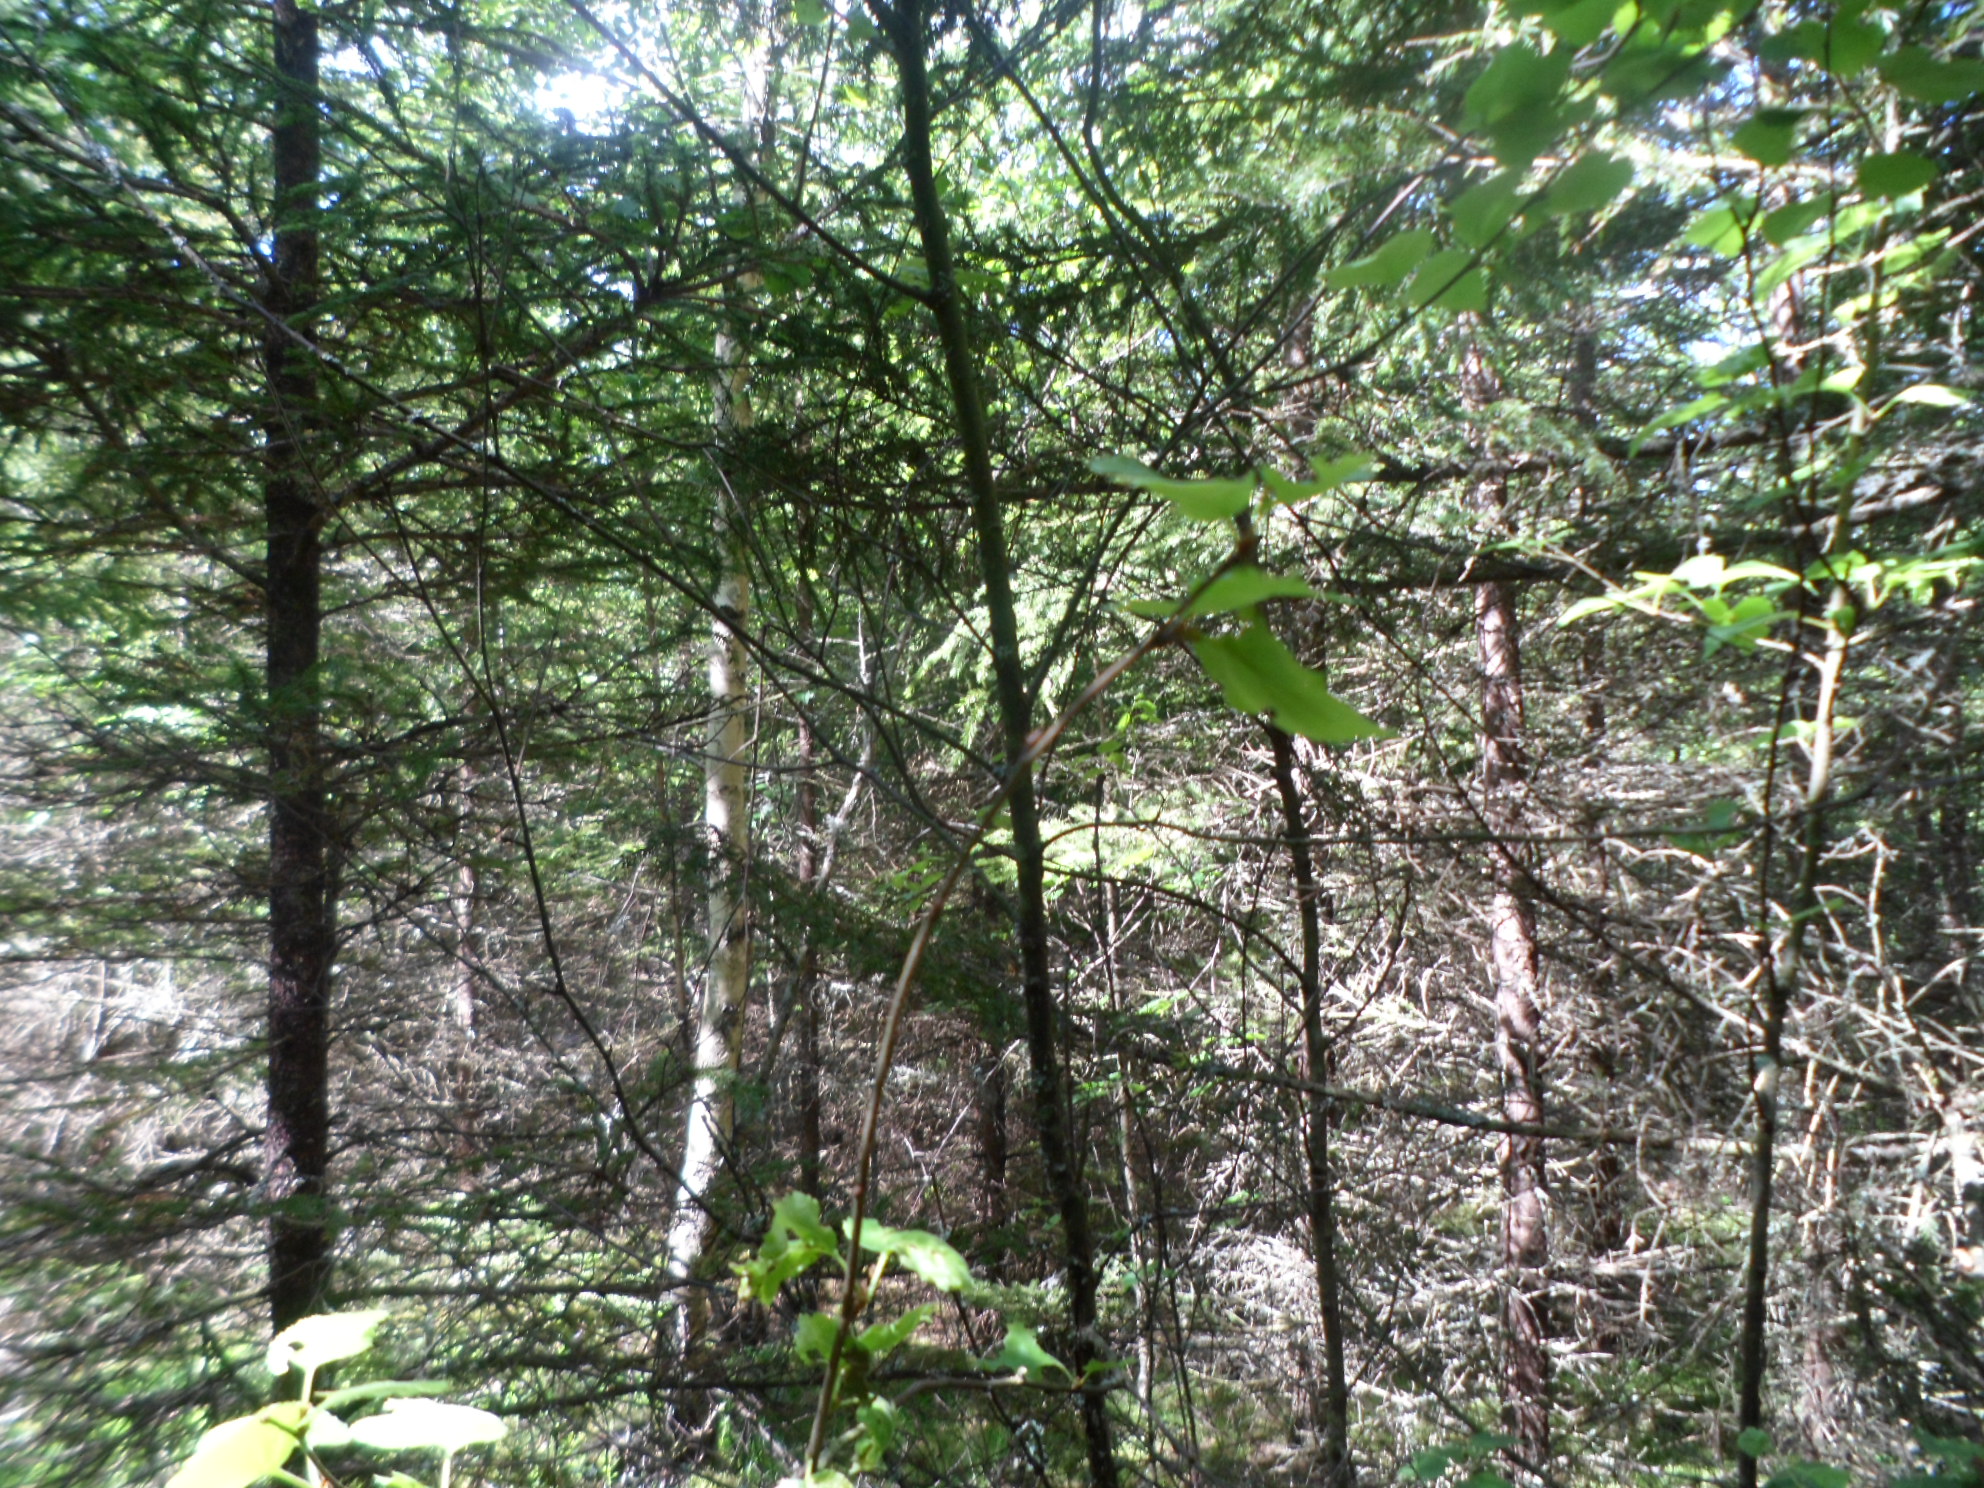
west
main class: Woodland
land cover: Spruce dominated coniferous woodland
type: boreal forest
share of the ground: > 75 %
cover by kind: coniferous forest trees 75 %, lichens and mosses 10 %, broadleaved forest trees 5 %, shrubs 5 %, herbaceous plants 5 %
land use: Forestry
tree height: > 5 m
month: July
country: SE
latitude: 57.4043
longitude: 14.5396
